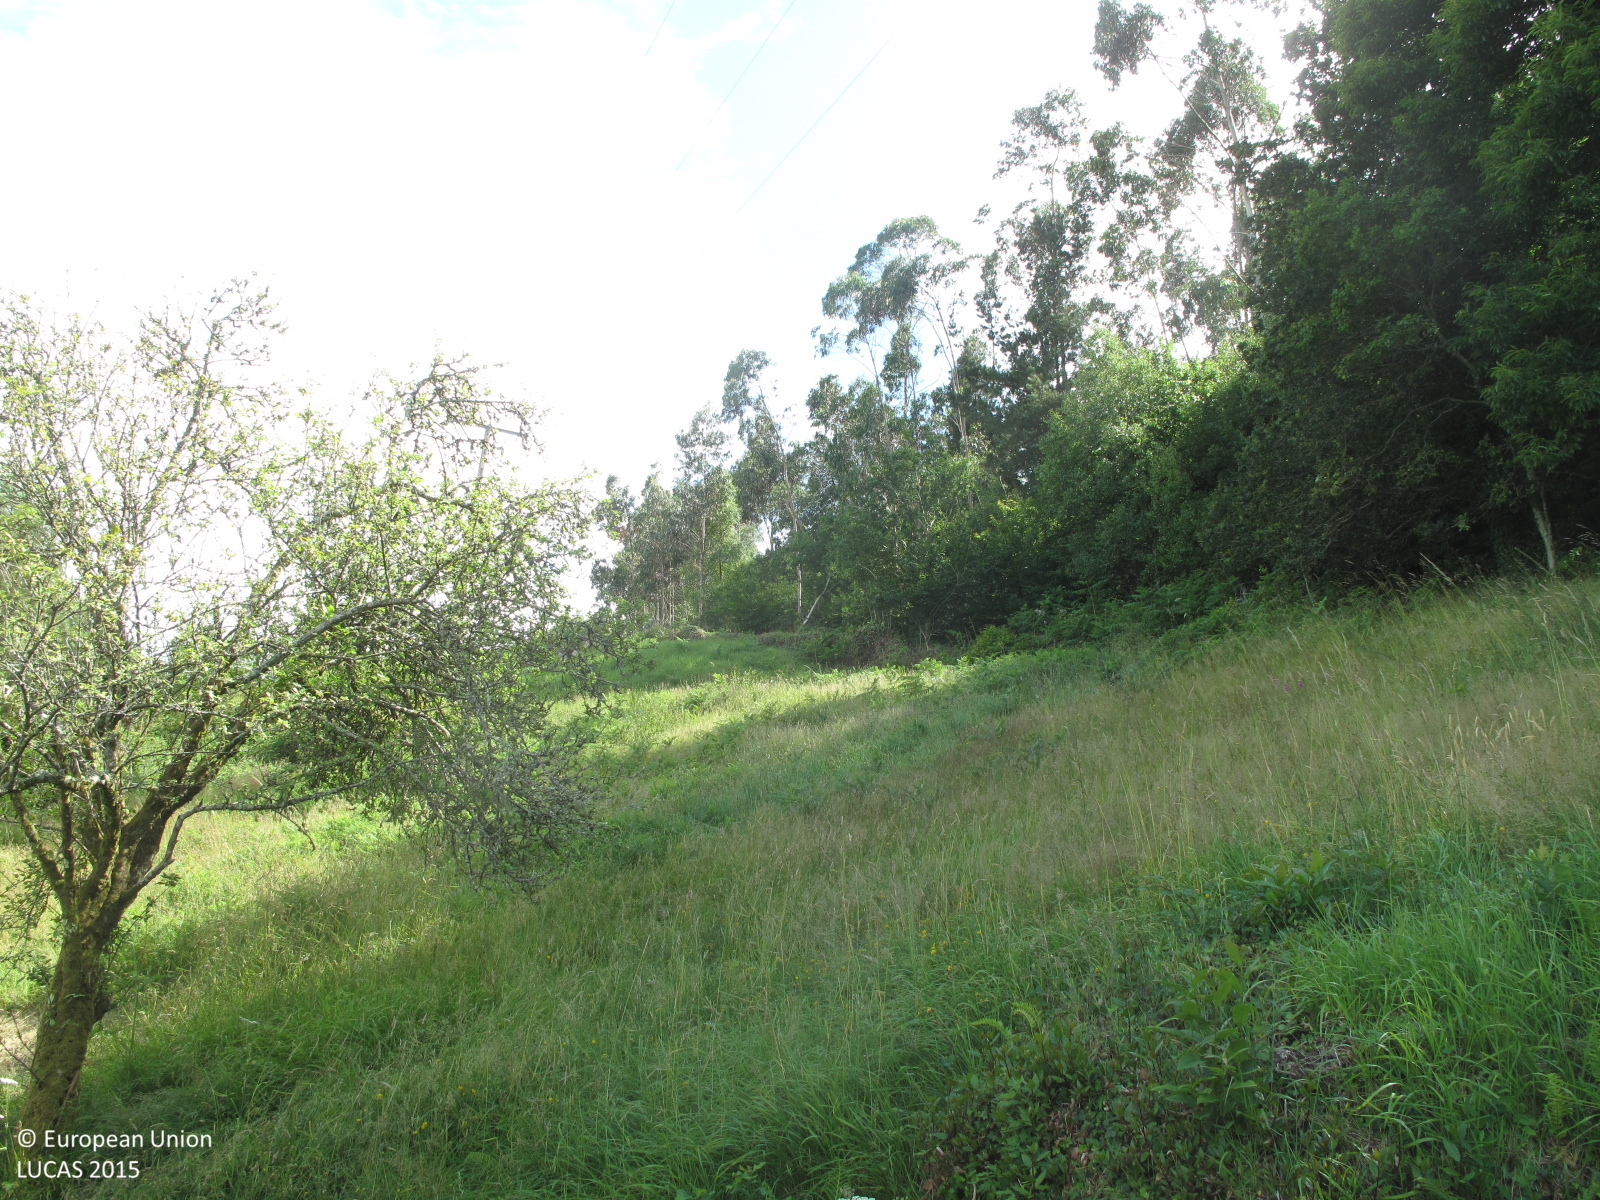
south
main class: Grassland
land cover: Grassland with sparse tree/shrub cover
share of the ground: > 75 %
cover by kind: herbaceous plants 90 %, broadleaved forest trees 5 %, shrubs 5 %
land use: Abandoned areas
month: July
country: ES
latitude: 43.2163
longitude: -8.5371
